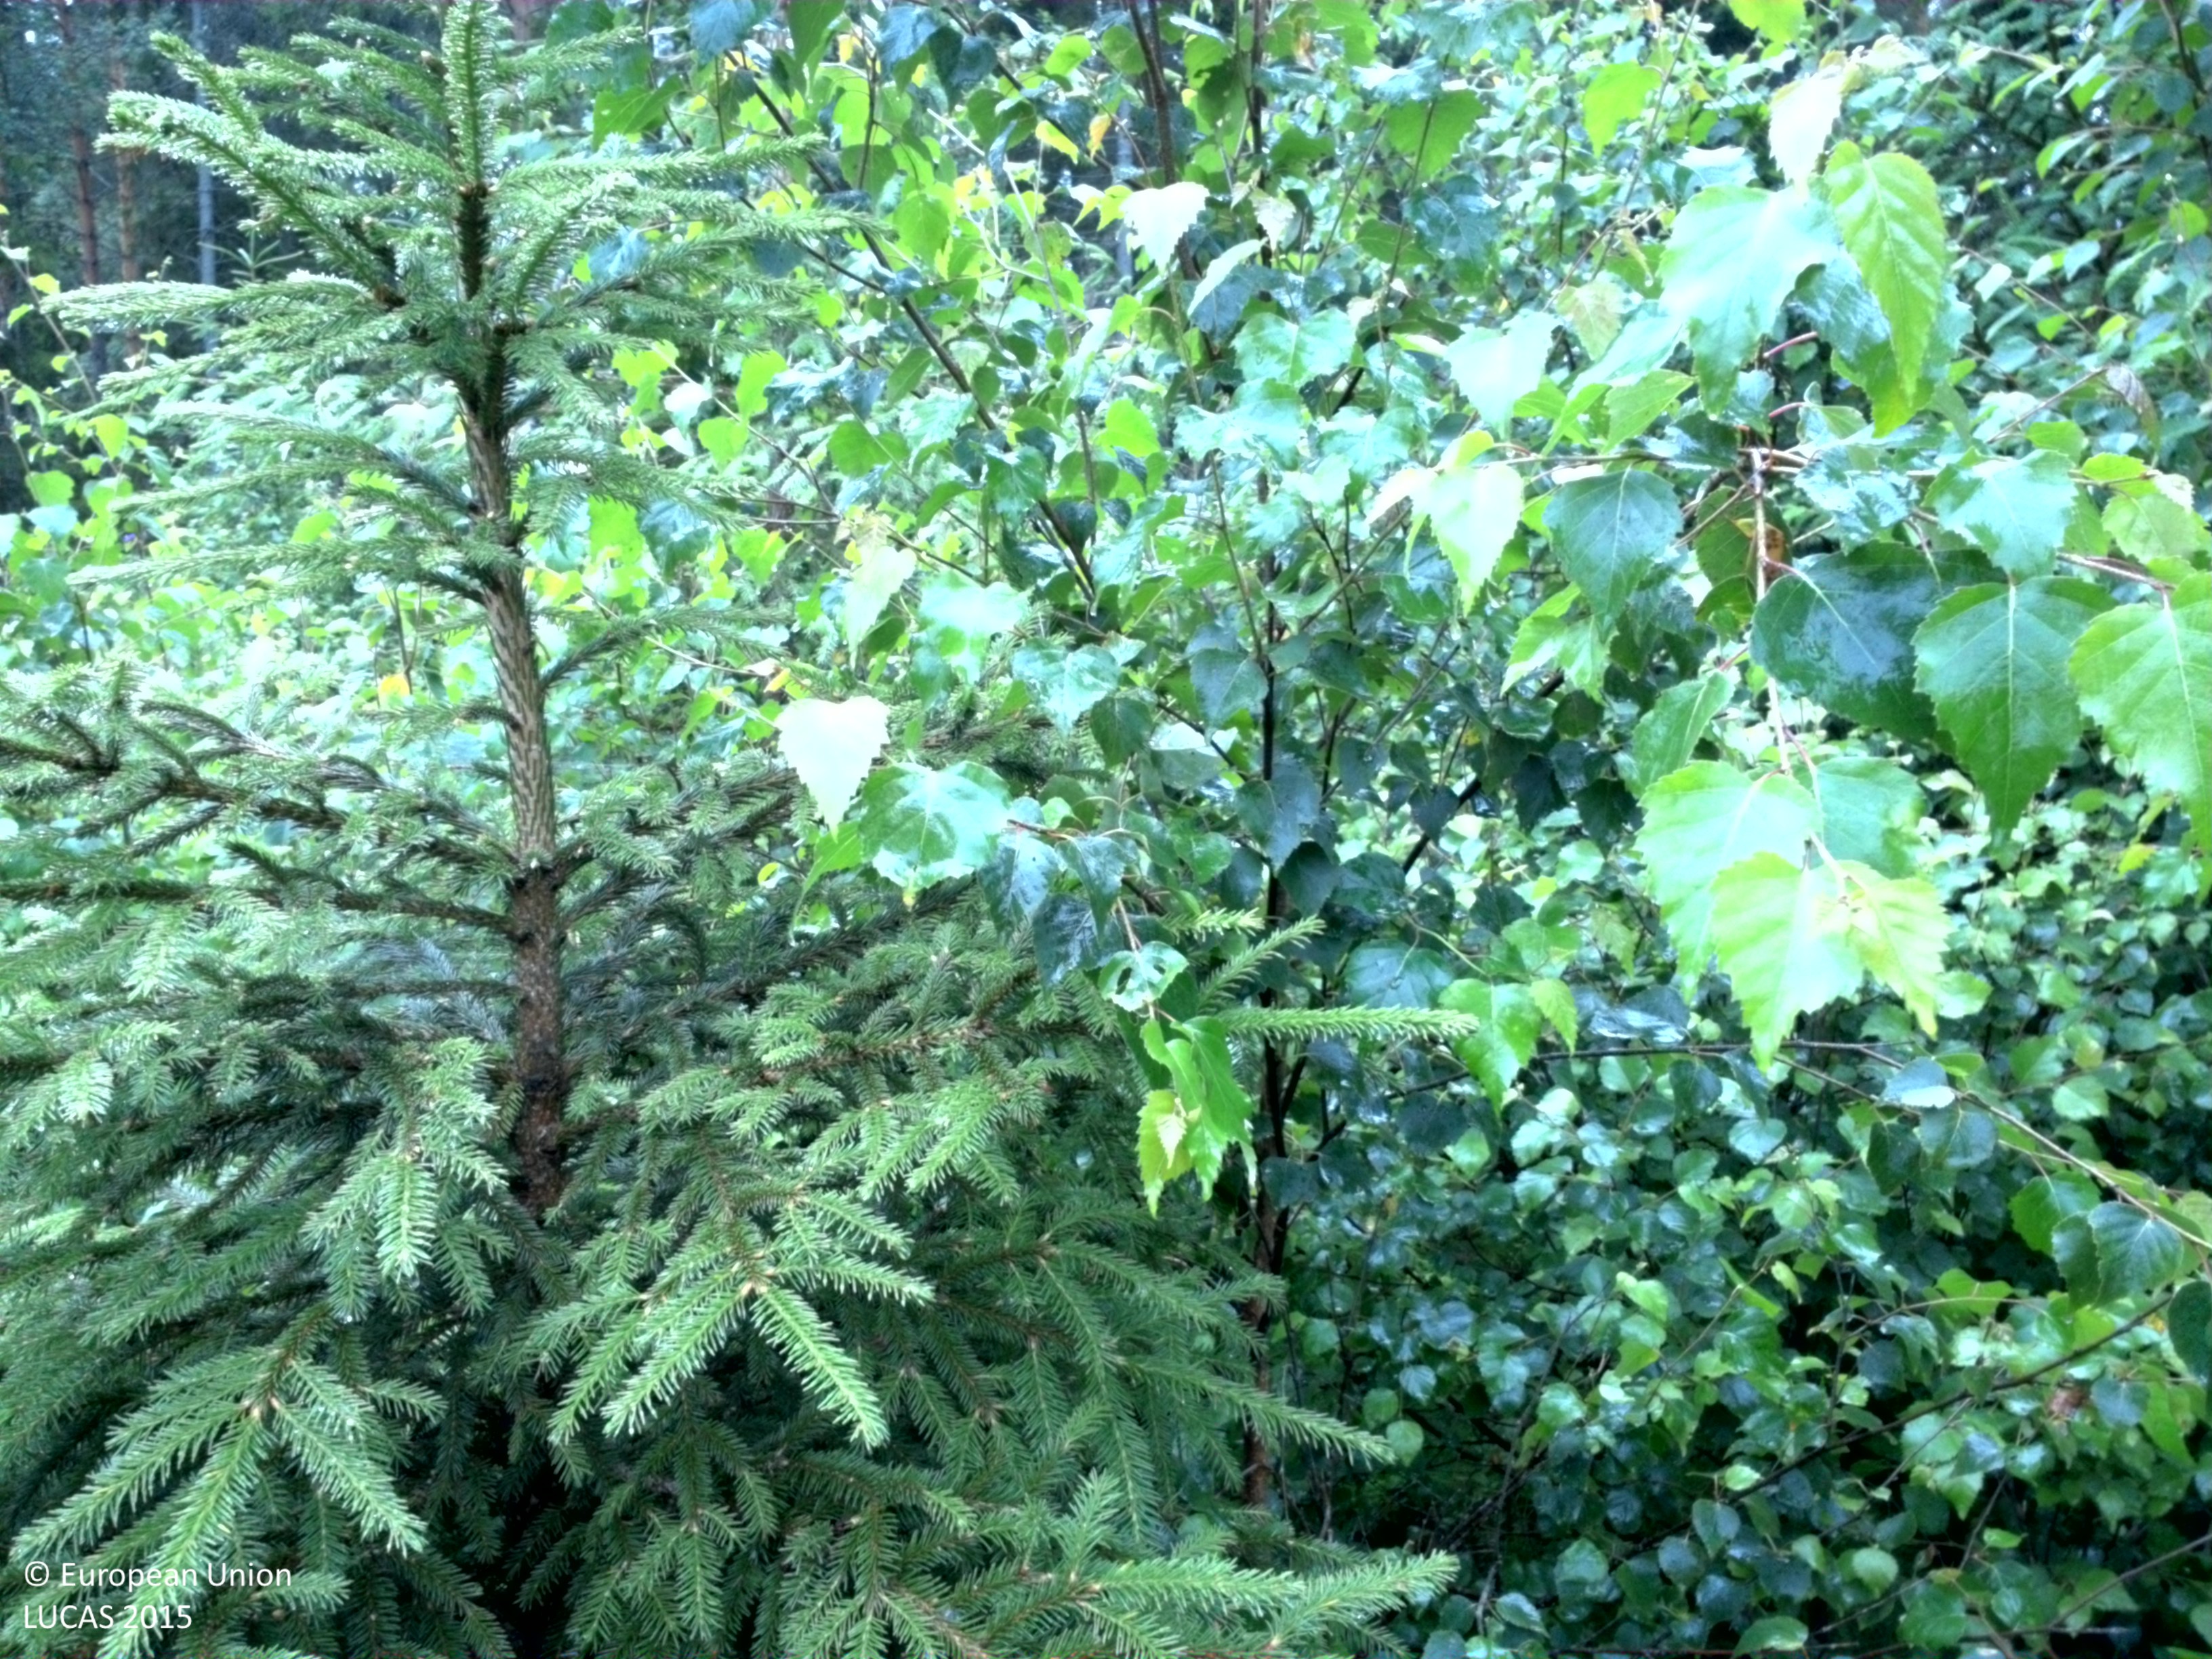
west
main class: Woodland
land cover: Spruce dominated mixed woodland
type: boreal forest
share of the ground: 25 - 50 %
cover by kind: herbaceous plants 60 %, coniferous forest trees 30 %, broadleaved forest trees 10 %
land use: Forestry
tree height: < 5 m
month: July
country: SE
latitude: 59.9761
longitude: 17.2490
